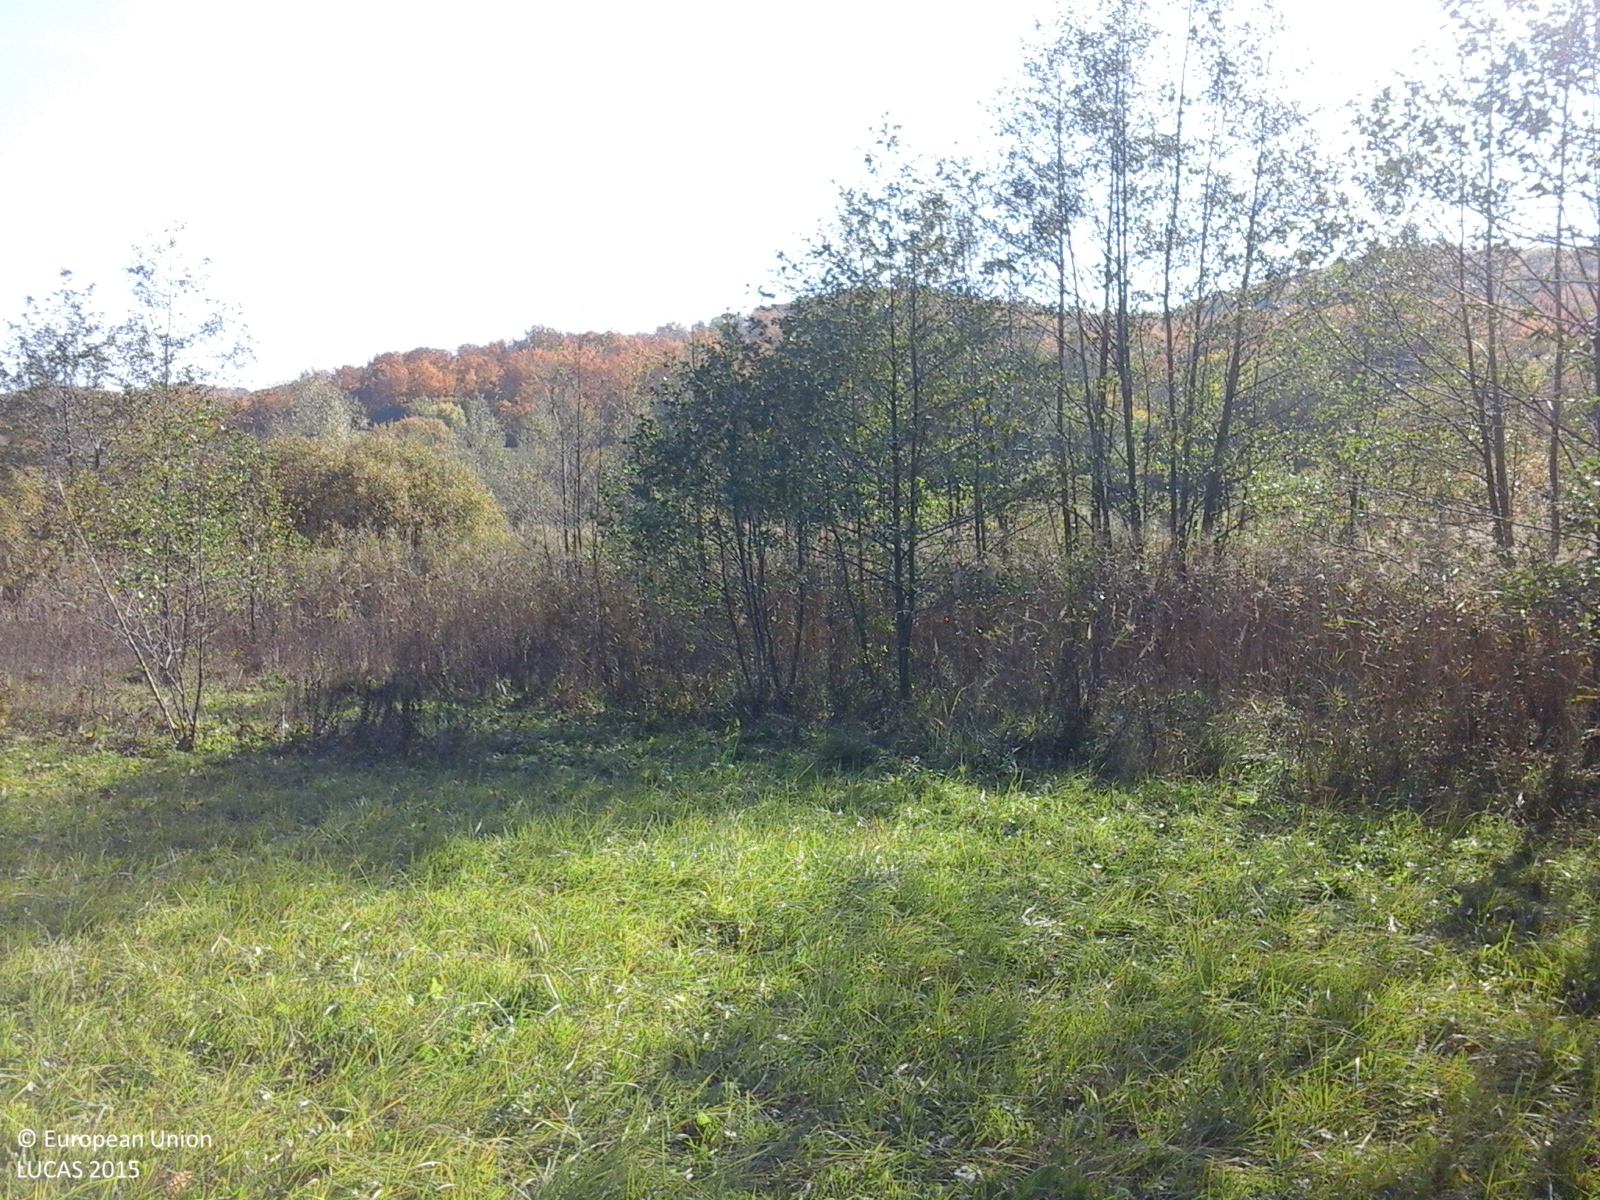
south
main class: Grassland
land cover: Grassland without tree/shrub cover
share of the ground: > 75 %
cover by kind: herbaceous plants 100 %
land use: Agriculture (excluding fallow land and kitchen gardens)
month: October
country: RO
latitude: 46.0511
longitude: 26.9575
